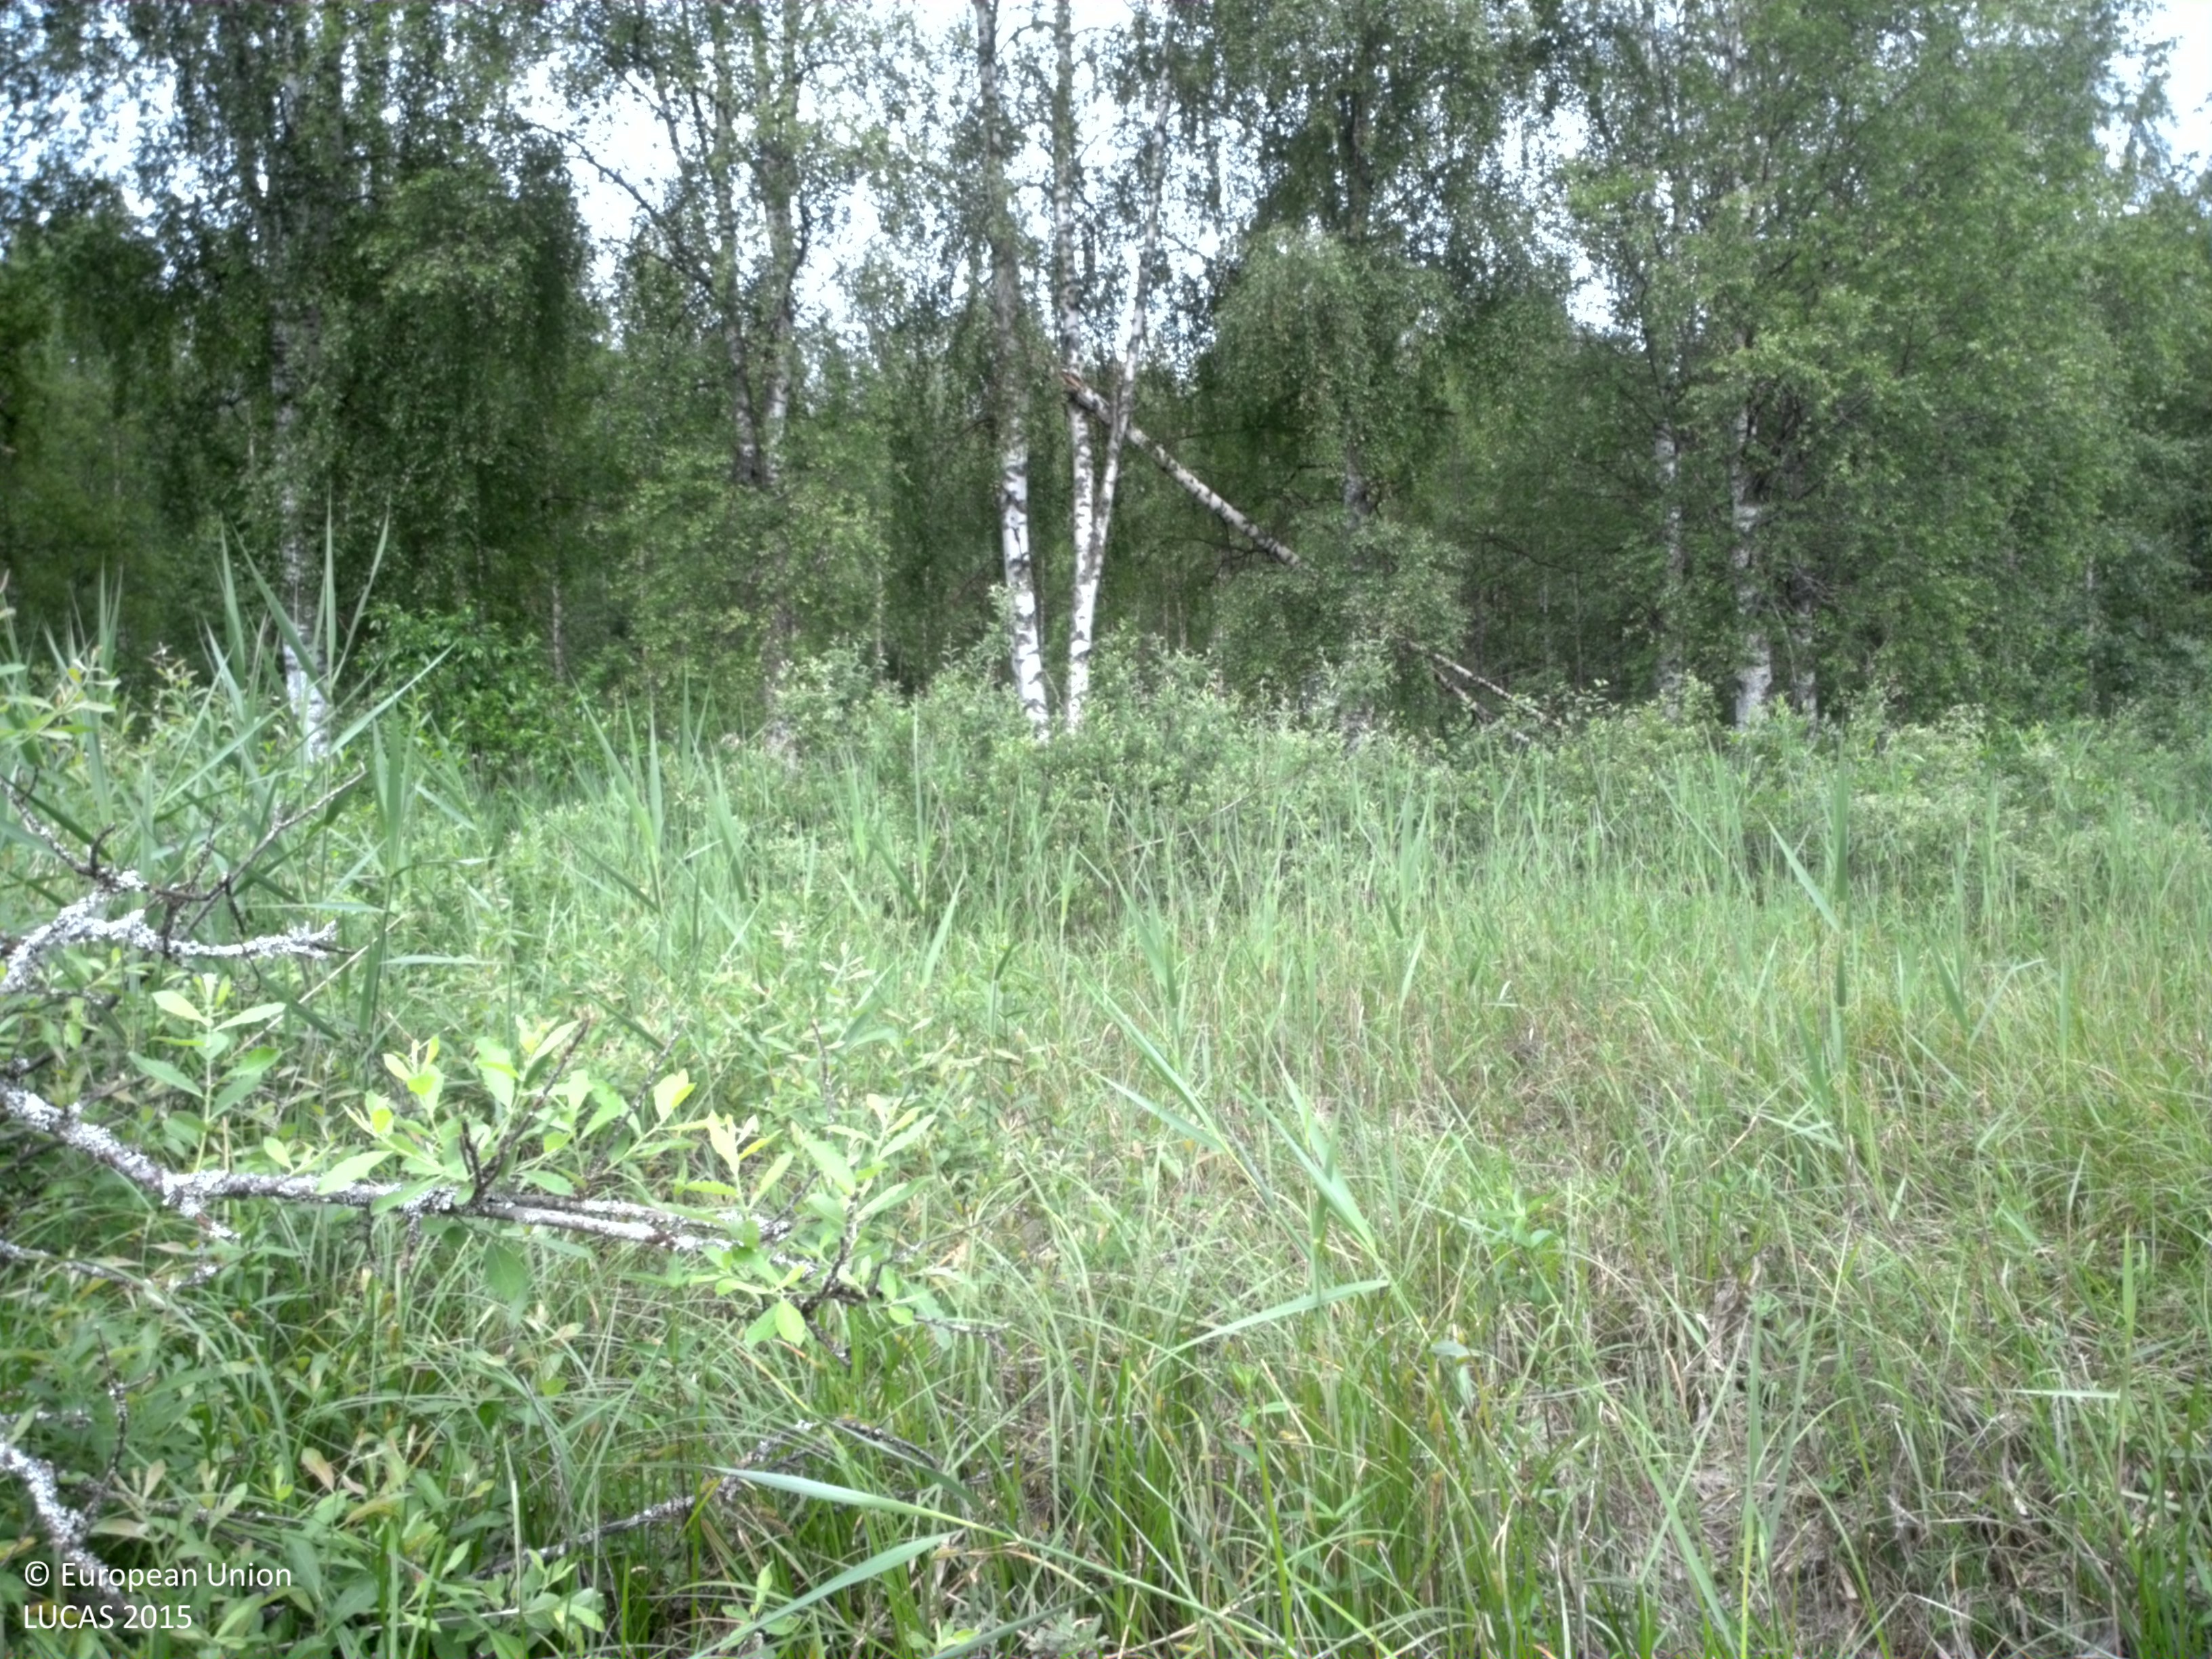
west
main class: Shrubland
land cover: Shrubland with sparse tree cover
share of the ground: 50 - 75 %
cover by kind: shrubs 55 %, herbaceous plants 40 %, broadleaved forest trees 5 %
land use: Semi-natural and natural areas not in use
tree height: < 5 m
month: July
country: SE
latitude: 59.8062
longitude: 12.0087
